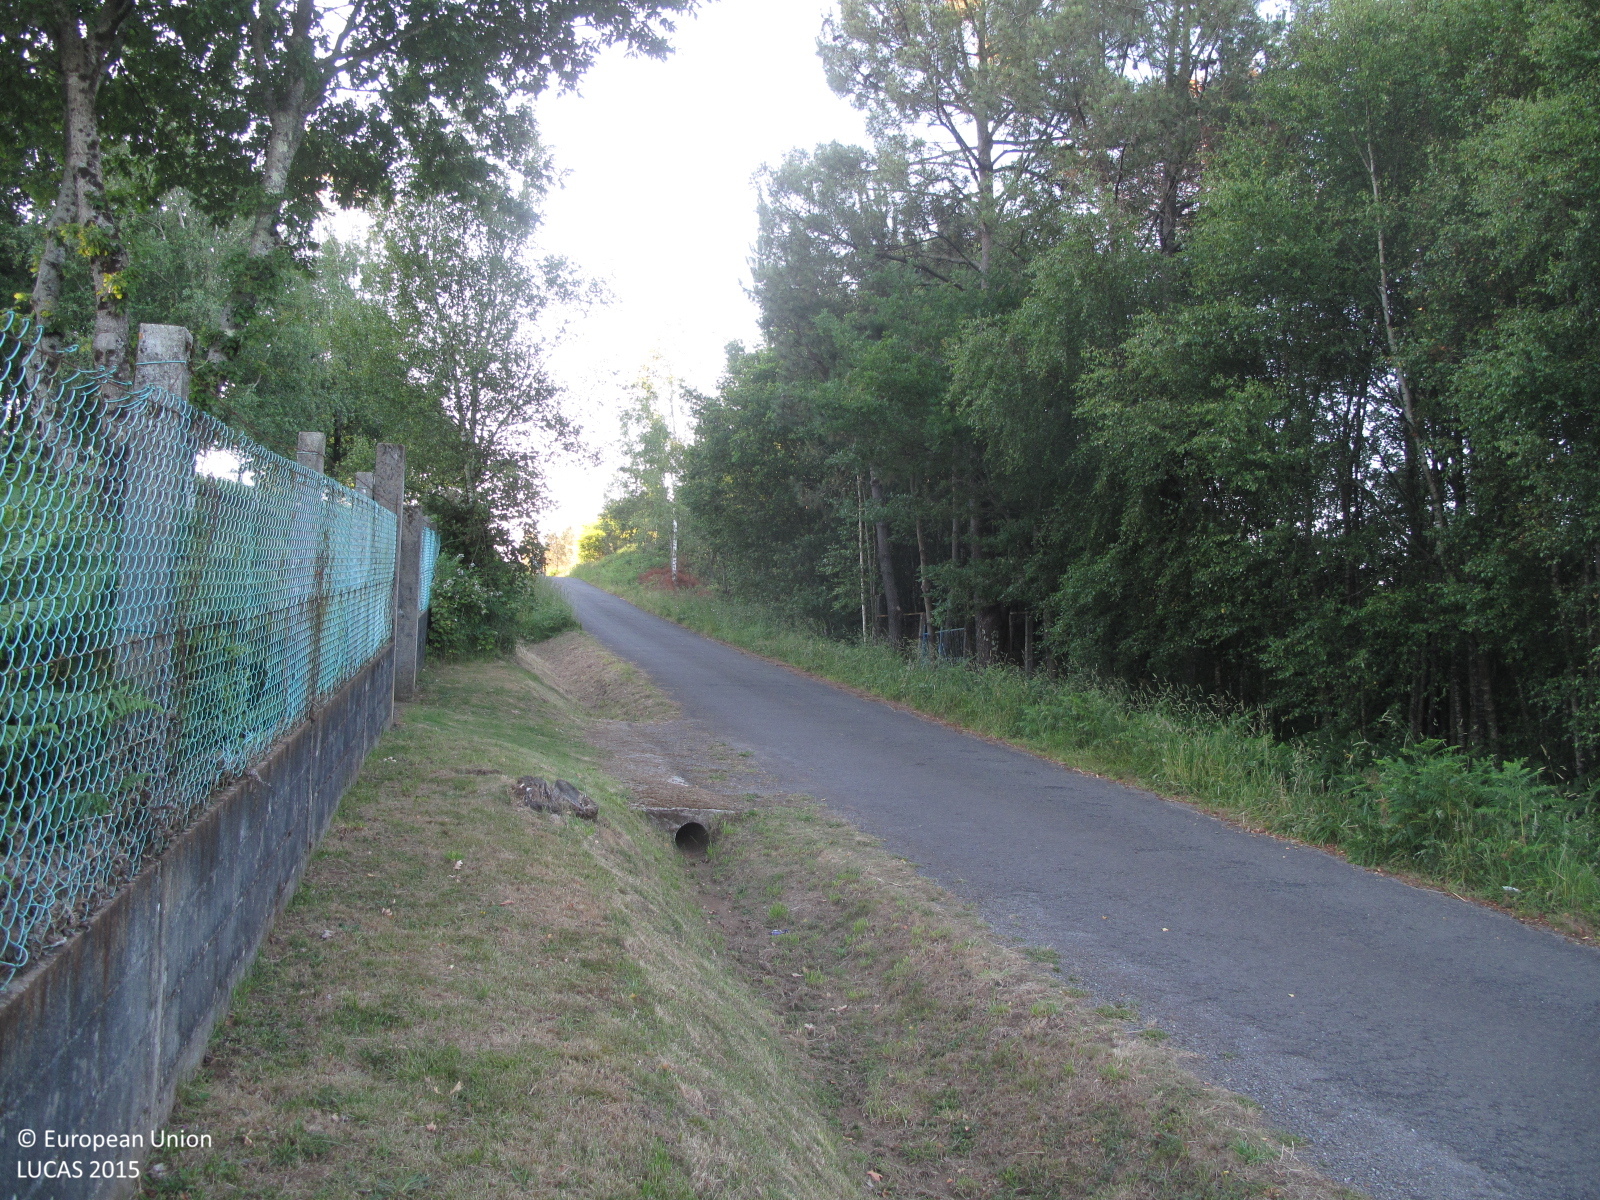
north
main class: Woodland
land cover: Broadleaved woodland
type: thermophilous deciduous forest
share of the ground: 10 - 25 %
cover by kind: herbaceous plants 70 %, broadleaved forest trees 20 %, shrubs 10 %
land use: Forestry
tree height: > 5 m
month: June
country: ES
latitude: 42.9590
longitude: -8.5301
